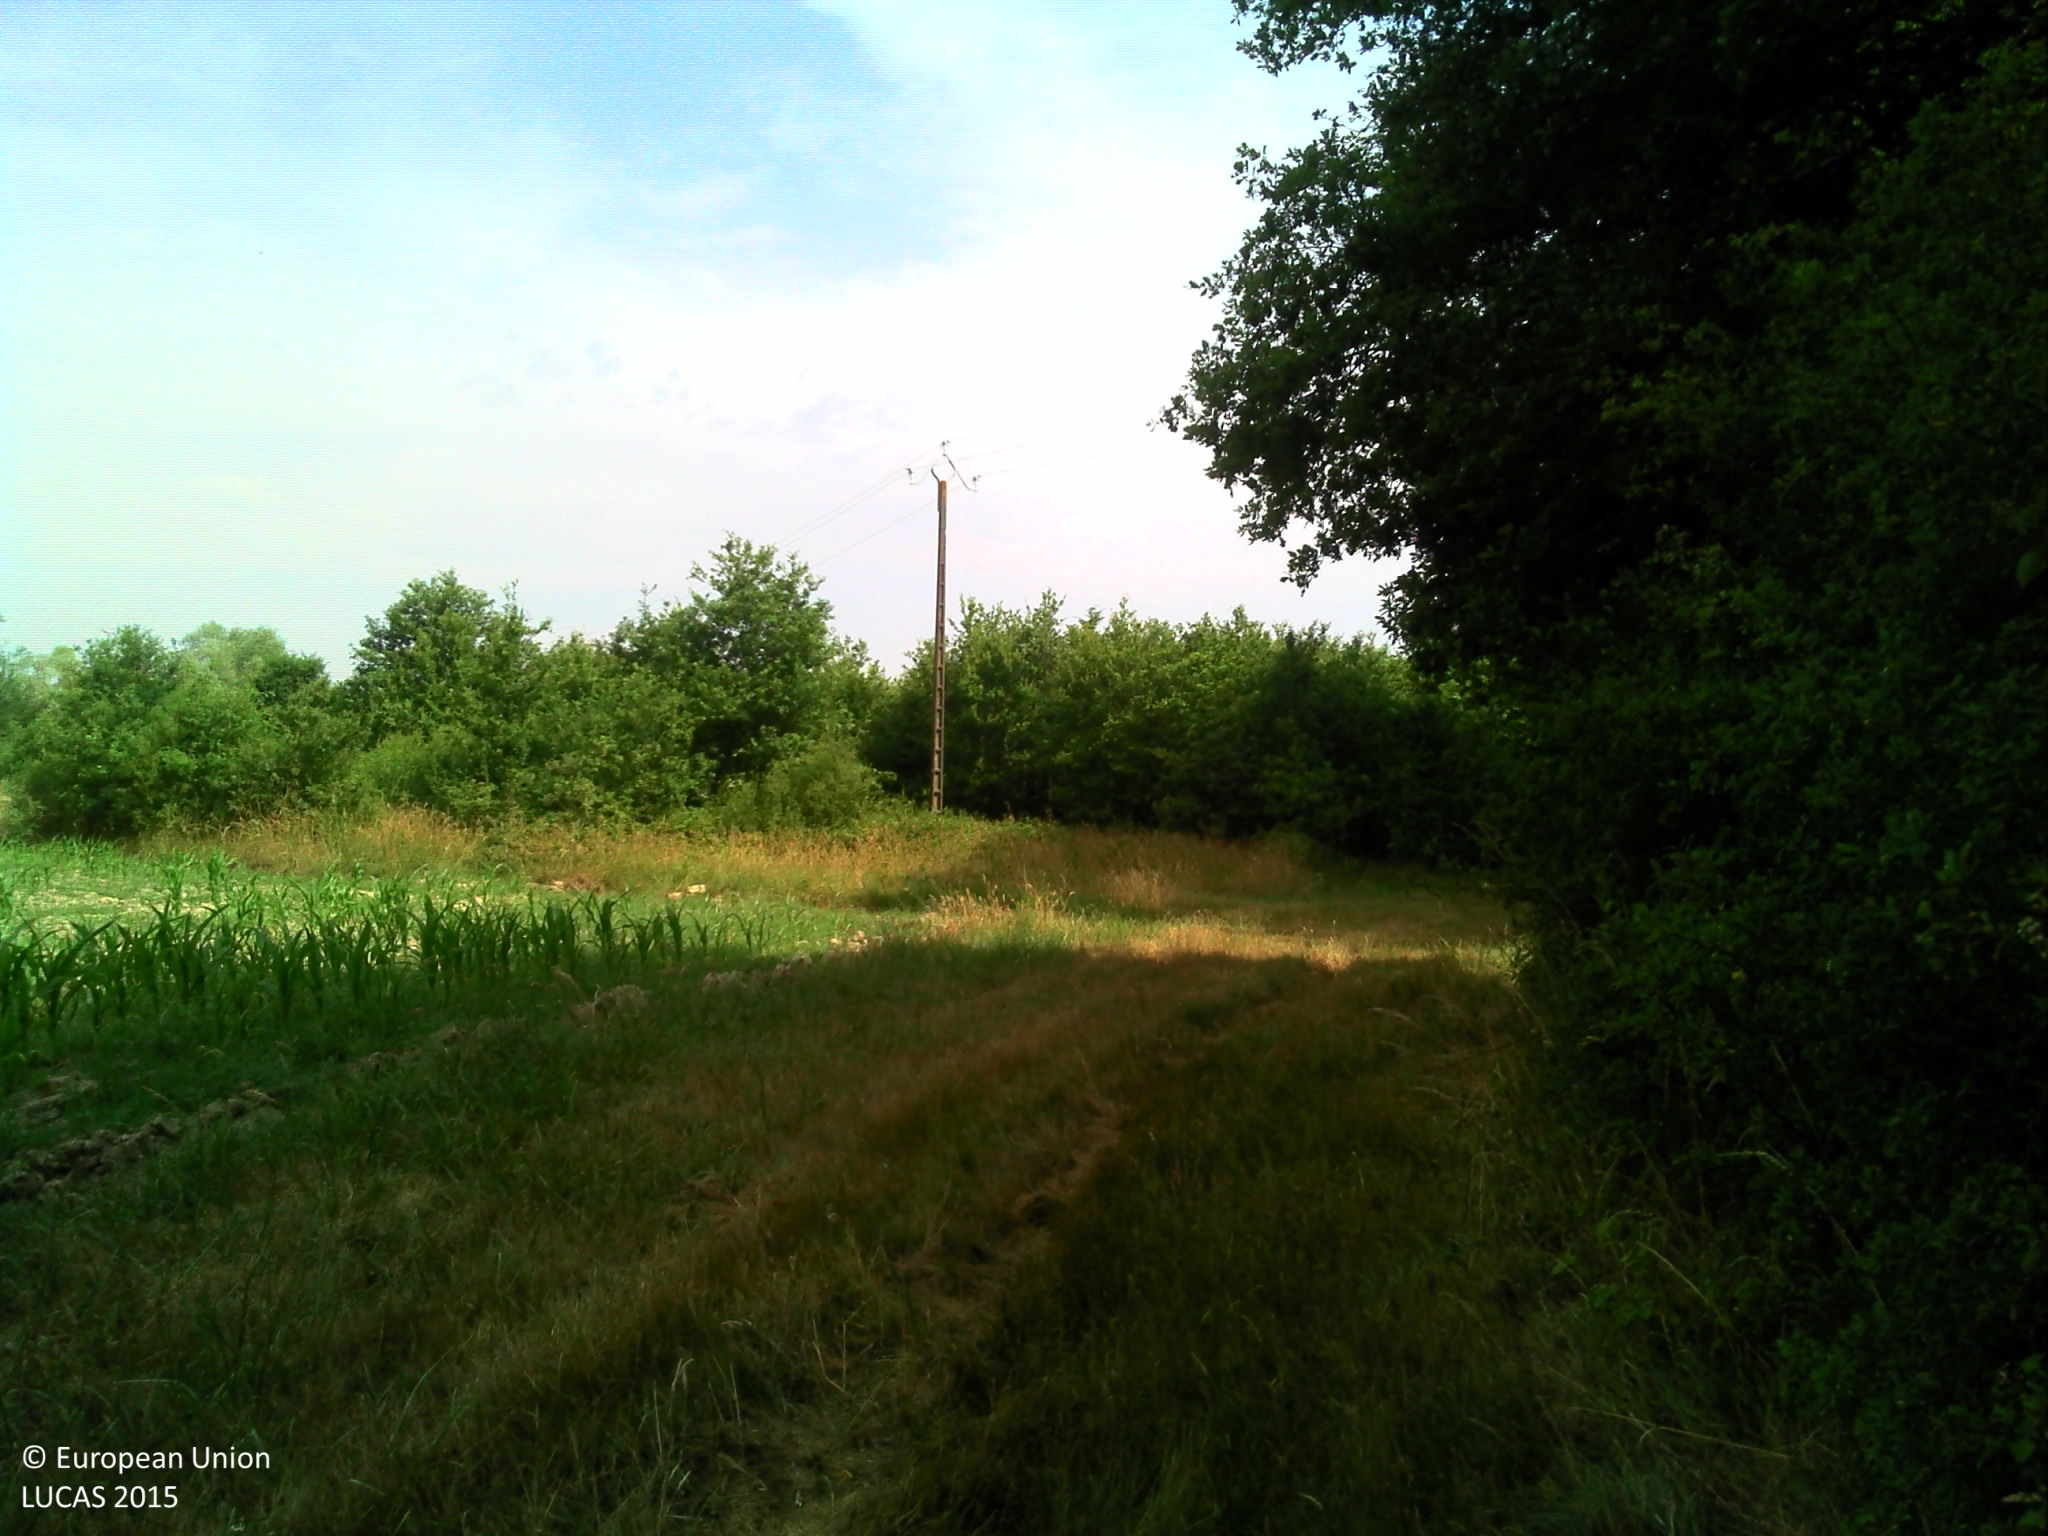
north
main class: Woodland
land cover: Broadleaved woodland
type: mesophytic deciduous forest
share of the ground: > 75 %
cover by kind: broadleaved forest trees 100 %
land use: Agriculture (excluding fallow land and kitchen gardens)
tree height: > 5 m
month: July
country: FR
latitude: 47.7354
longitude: 2.8053
